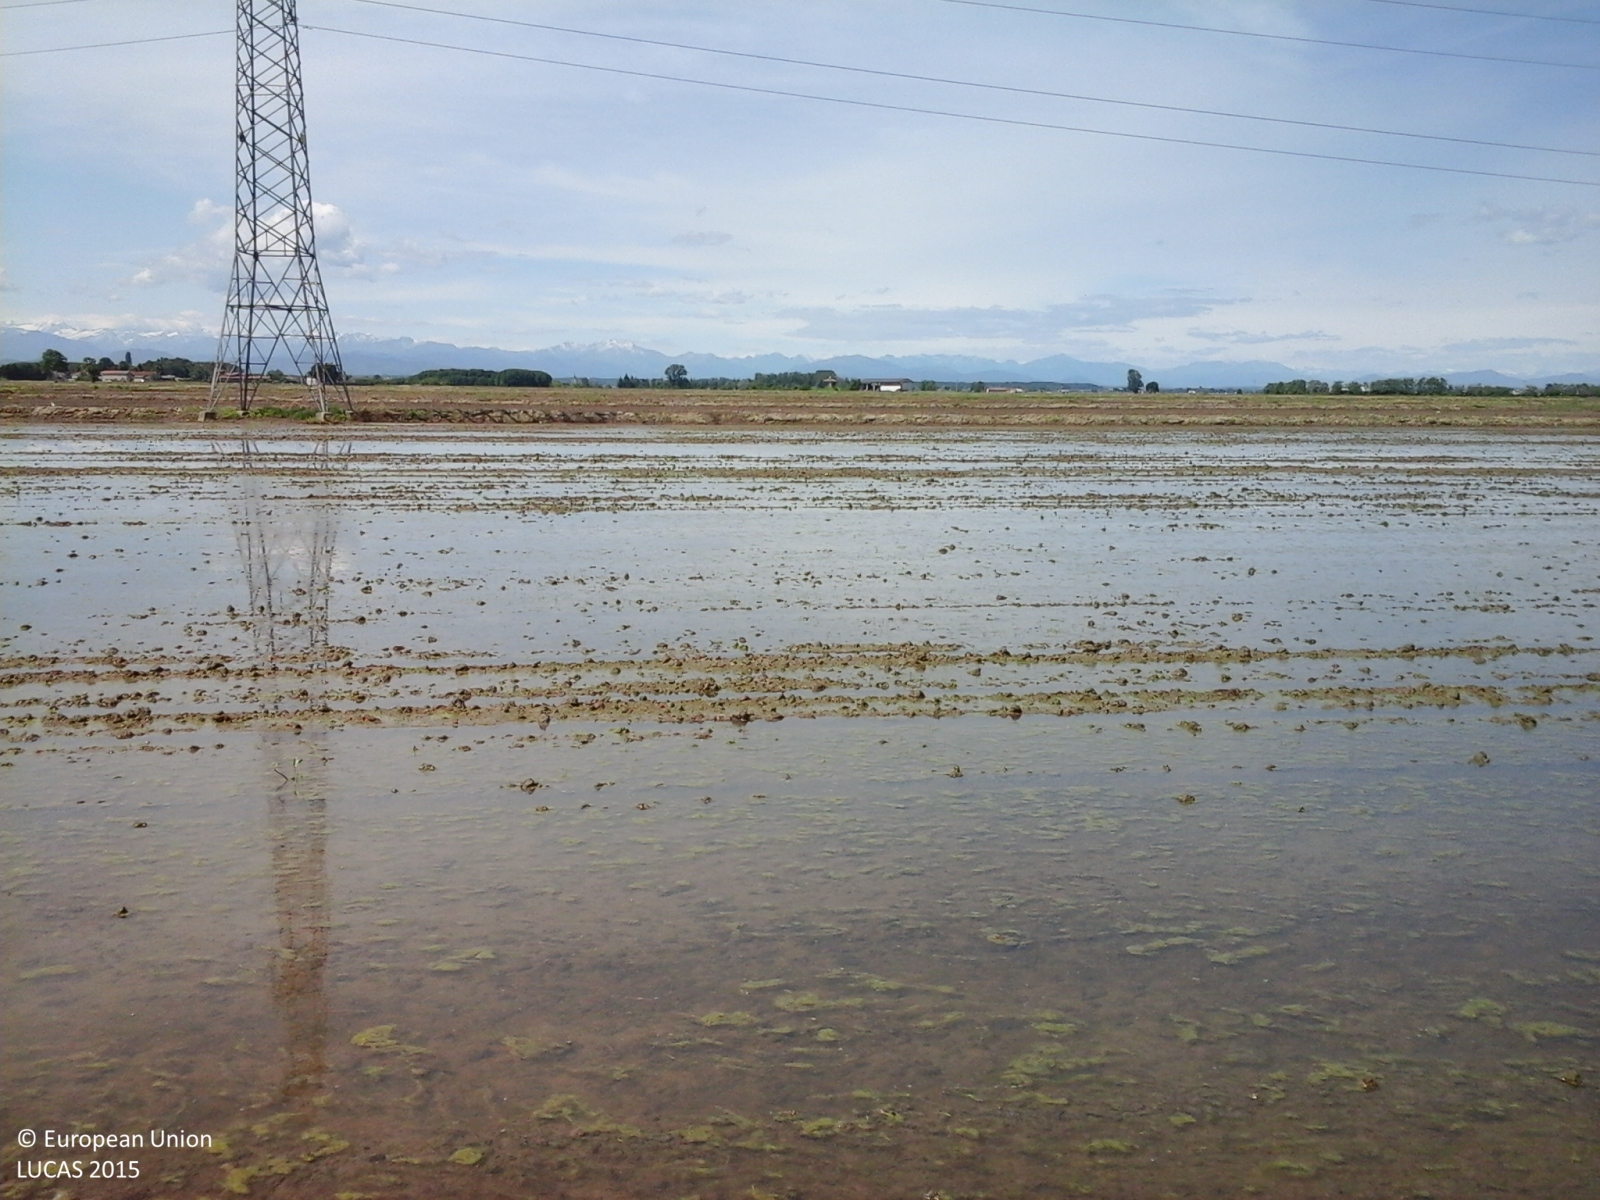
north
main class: Cropland
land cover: Rice
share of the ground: < 10 %
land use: Agriculture (excluding fallow land and kitchen gardens)
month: May
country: IT
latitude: 45.4758
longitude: 8.5058
